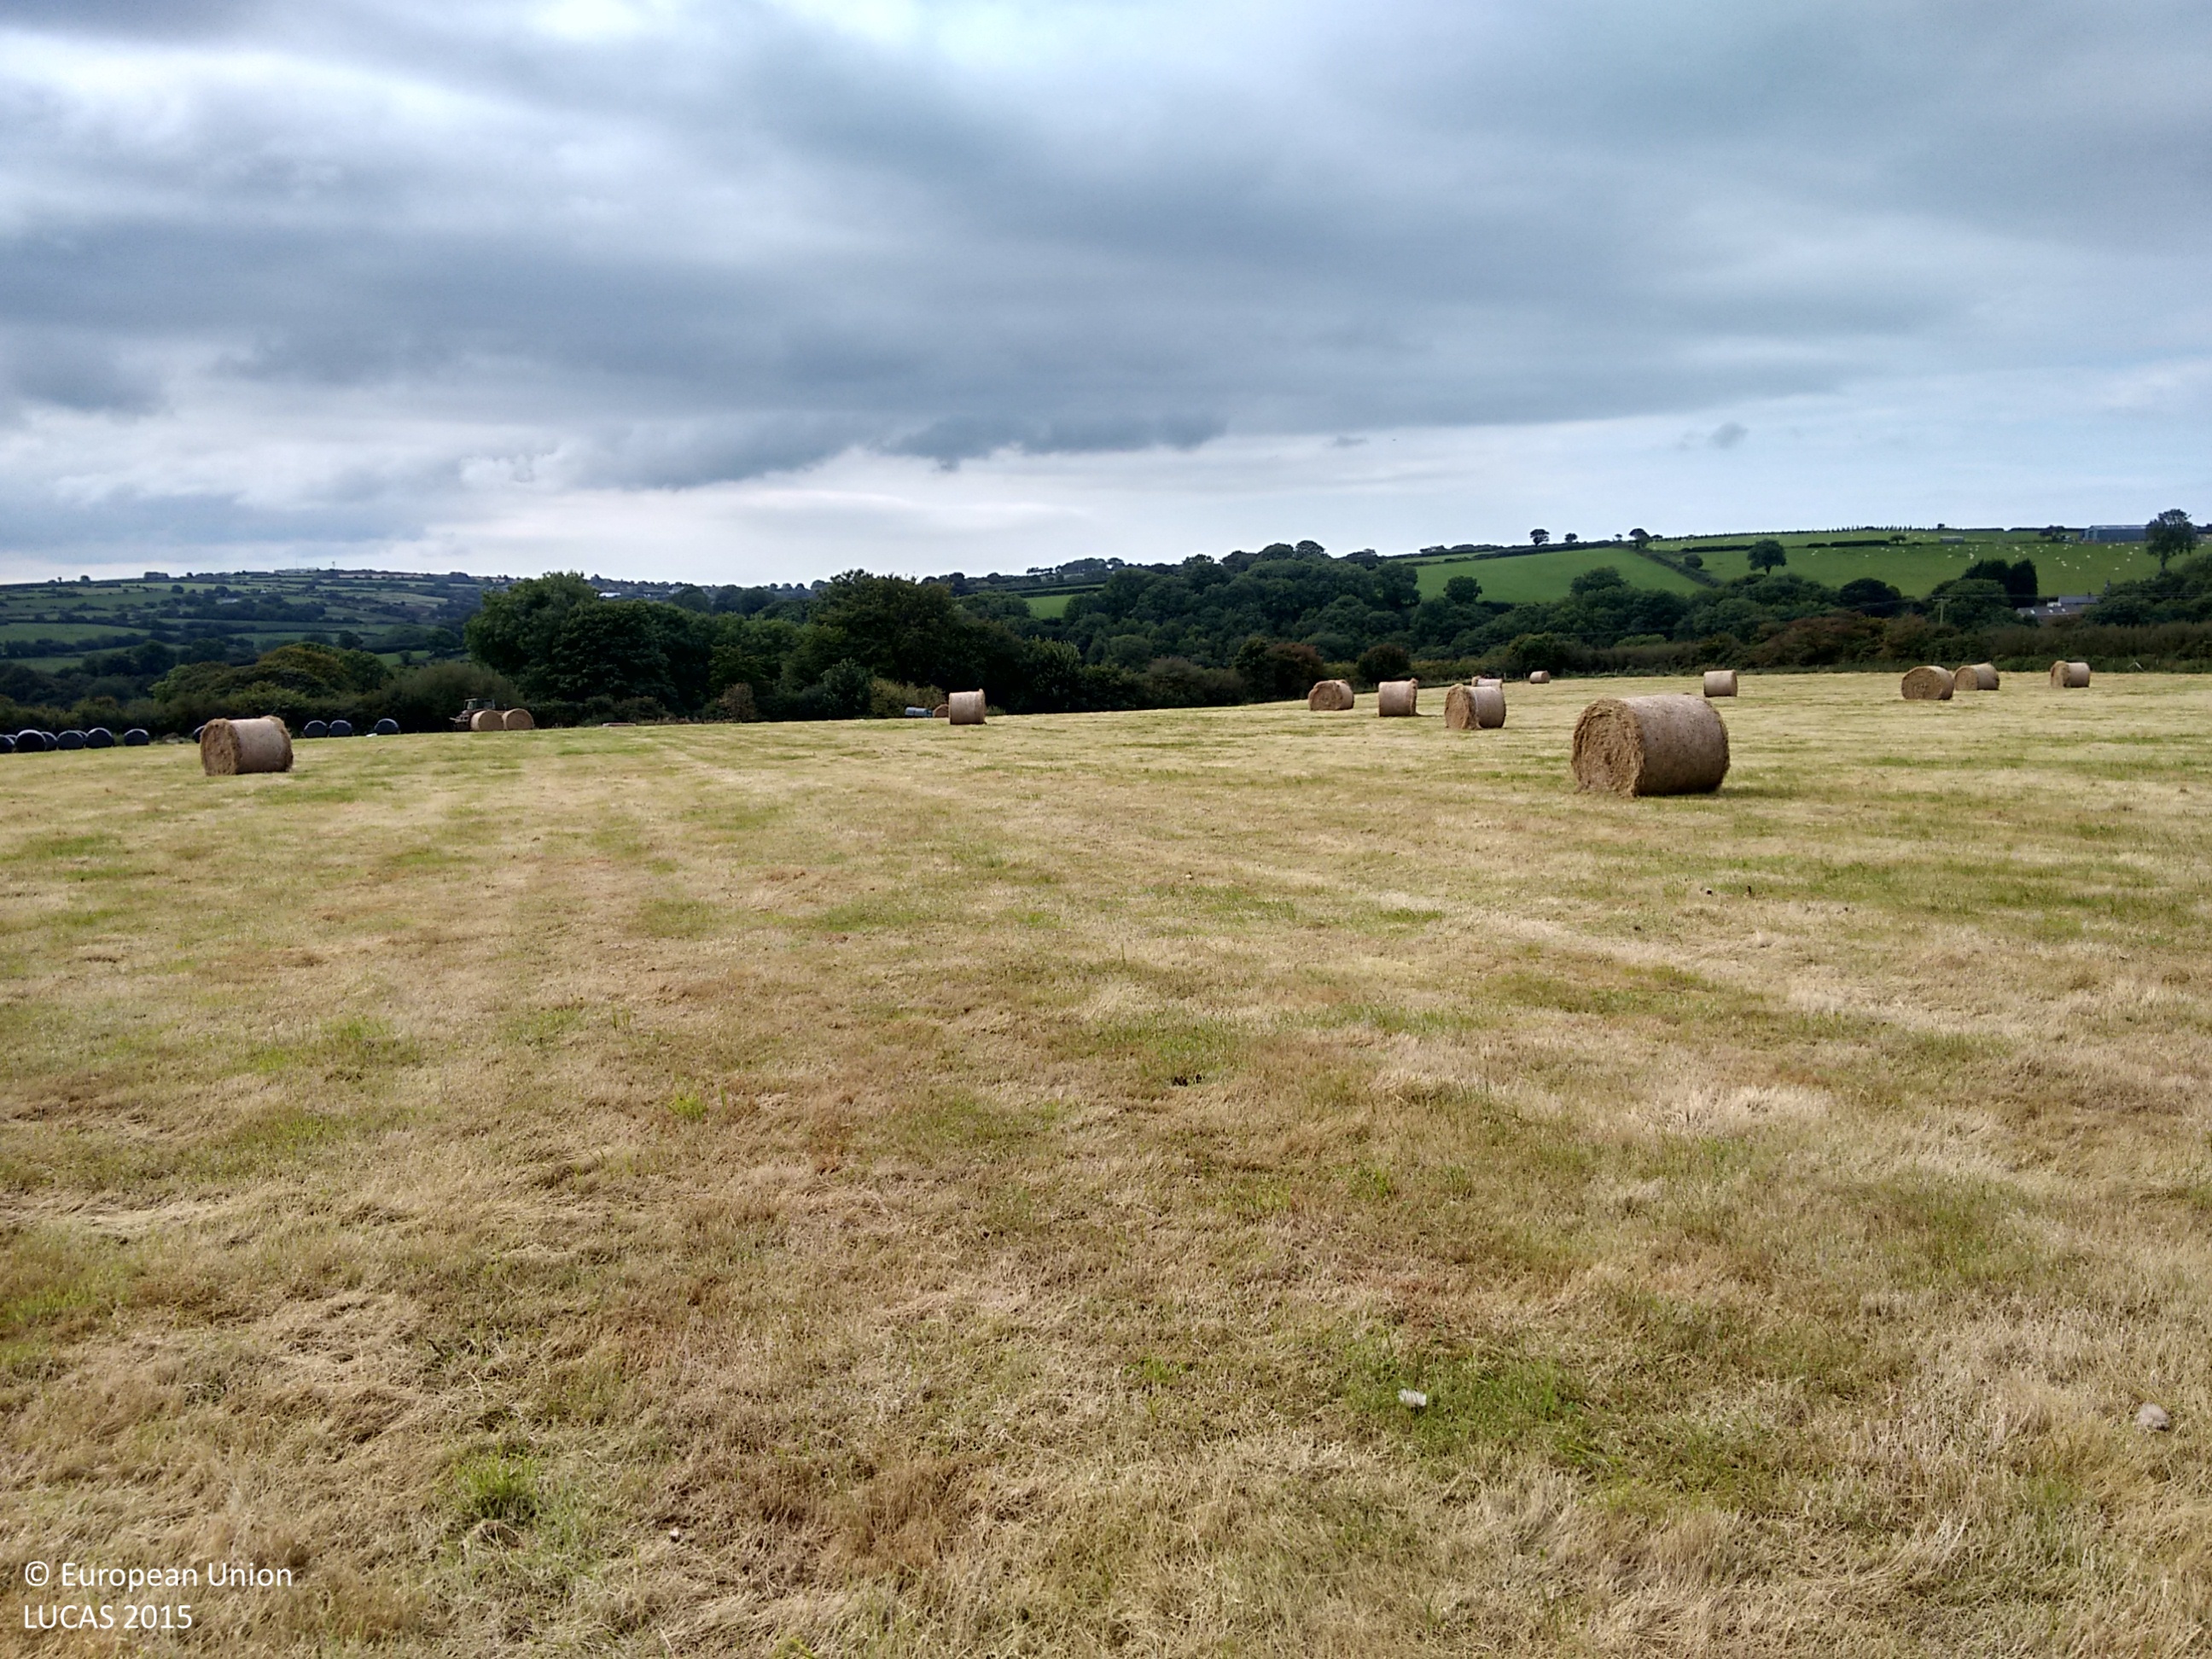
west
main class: Grassland
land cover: Grassland without tree/shrub cover
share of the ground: > 75 %
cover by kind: herbaceous plants 100 %
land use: Agriculture (excluding fallow land and kitchen gardens)
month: September
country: GB
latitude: 52.1251
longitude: -4.4630
